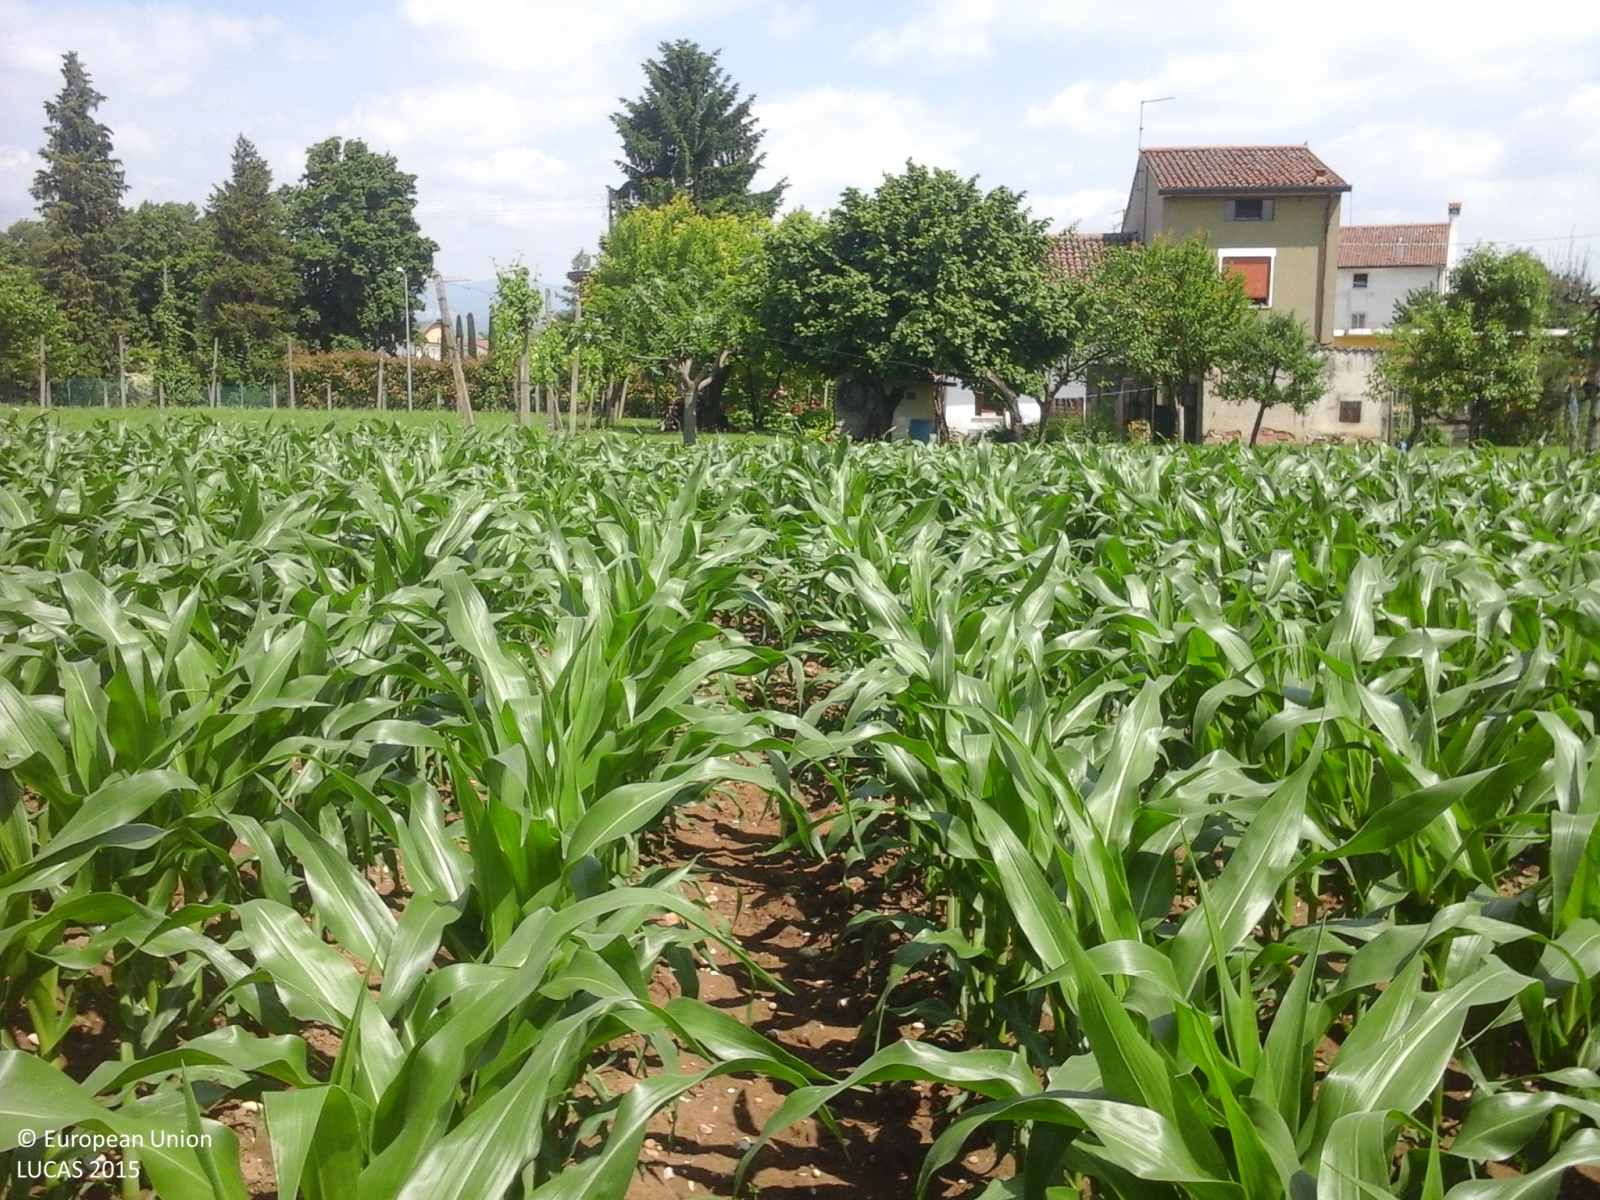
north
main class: Cropland
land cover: Maize
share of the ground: > 75 %
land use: Agriculture (excluding fallow land and kitchen gardens)
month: May
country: IT
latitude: 45.6545
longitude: 11.6016
